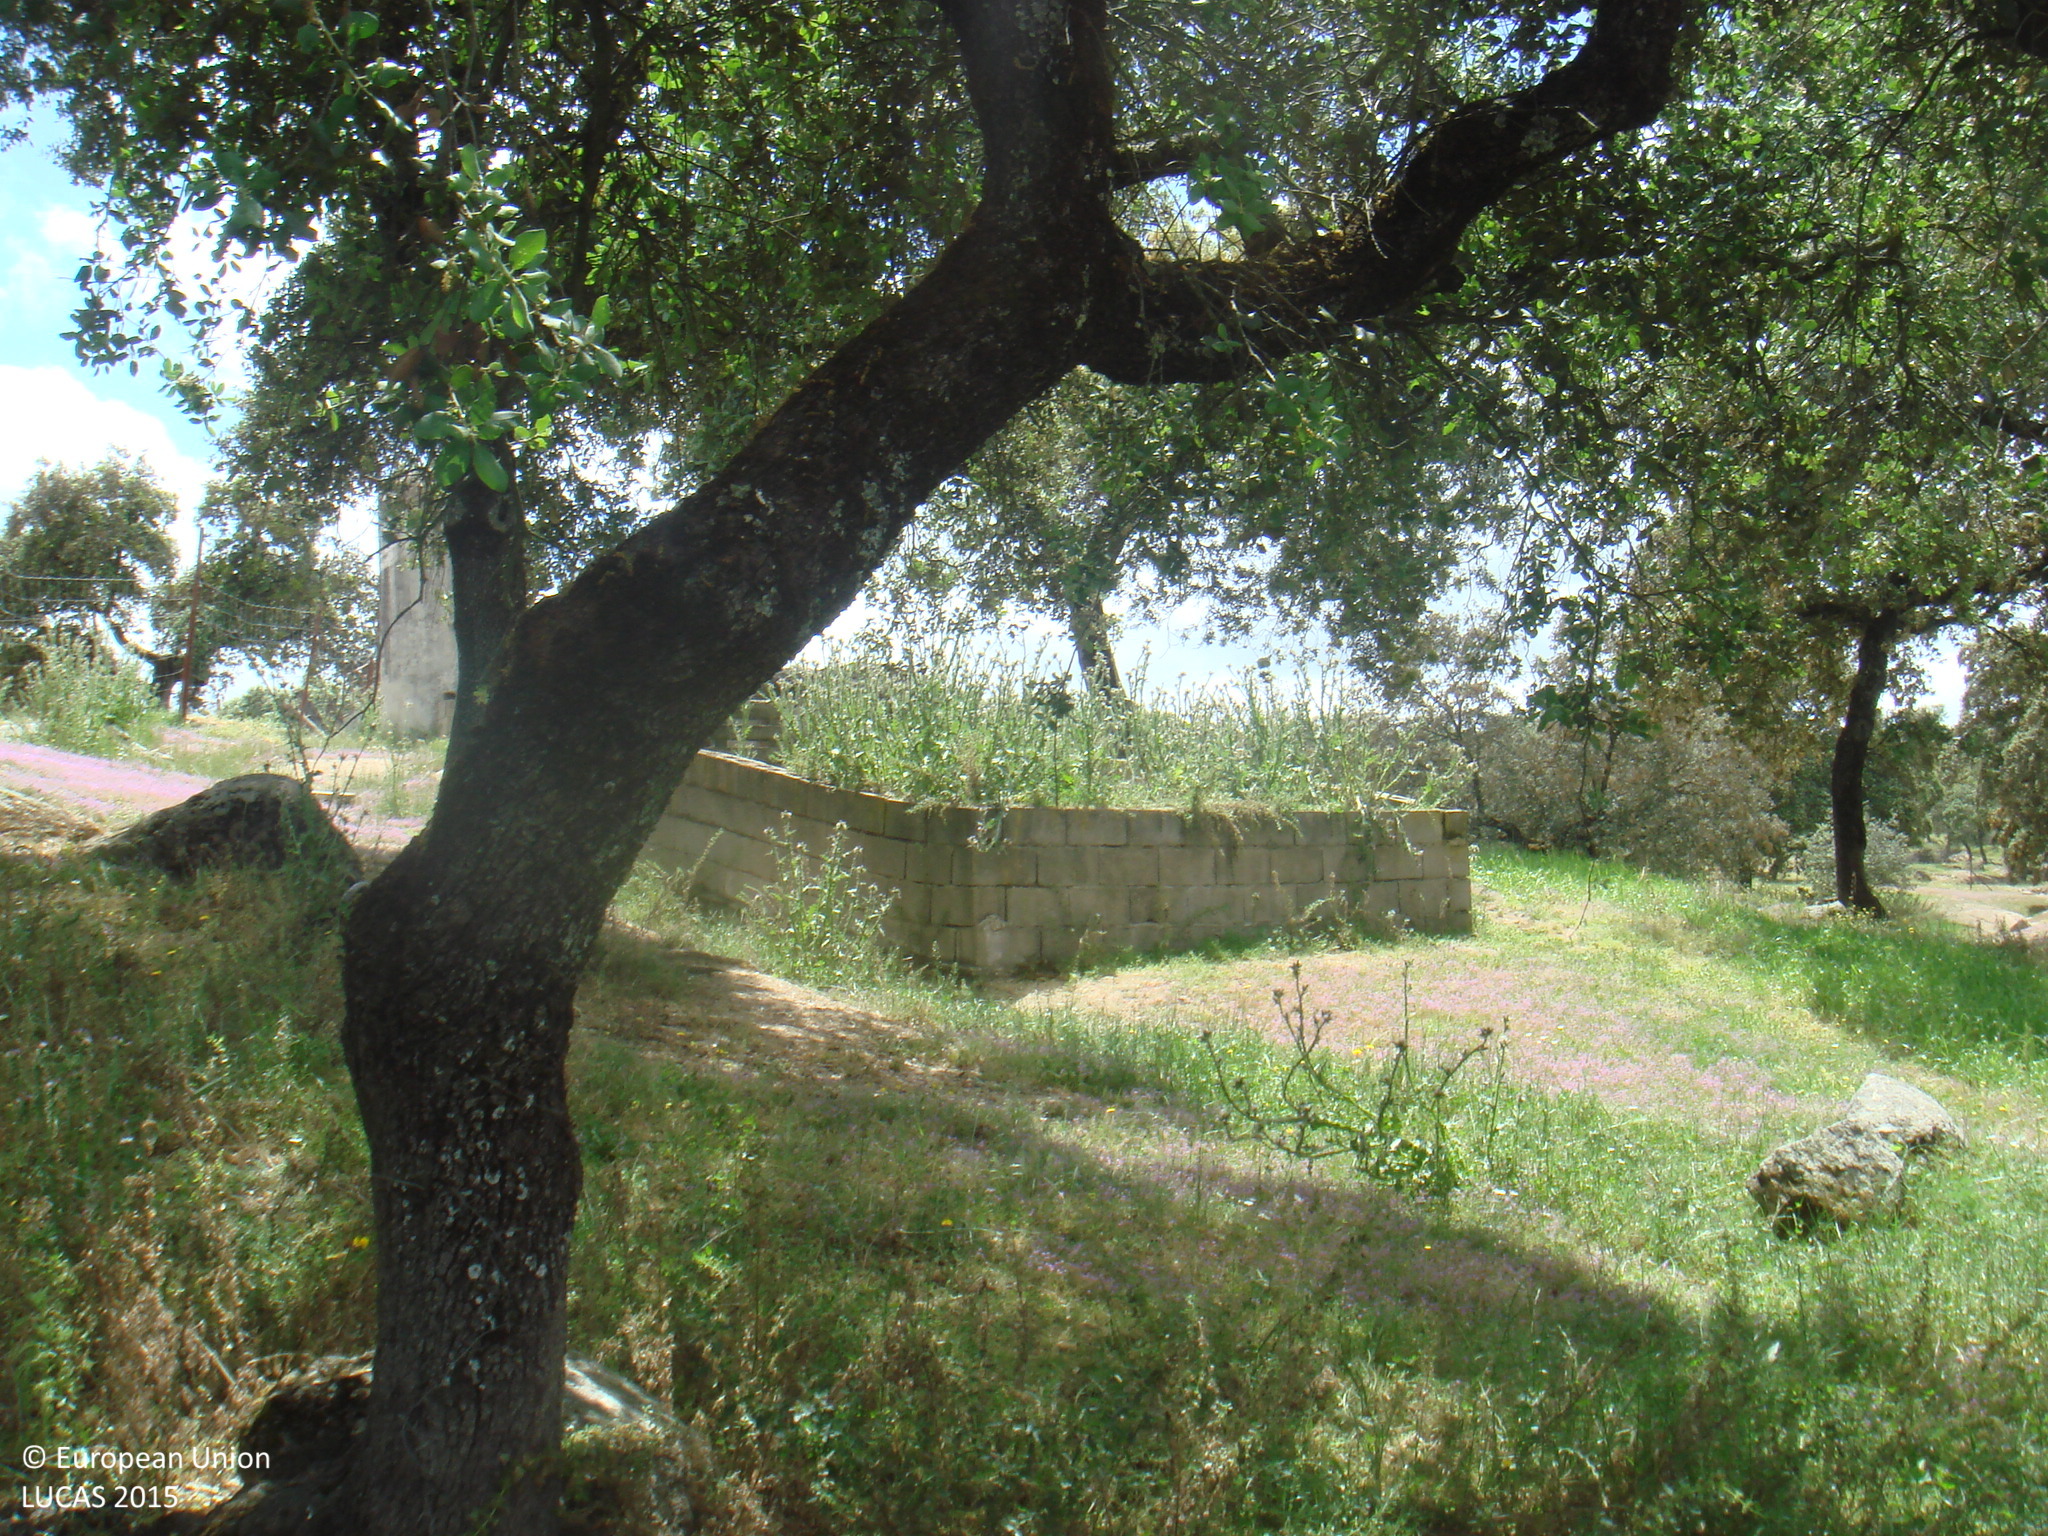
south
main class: Woodland
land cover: Broadleaved woodland
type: broadleaved evergreen forest
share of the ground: 50 - 75 %
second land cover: Spontaneously vegetated surfaces
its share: > 75 %
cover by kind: herbaceous plants 60 %, broadleaved forest trees 40 %
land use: Forestry
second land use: Agriculture (excluding fallow land and kitchen gardens)
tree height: > 5 m
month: May
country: ES
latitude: 38.3111
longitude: -4.3224
